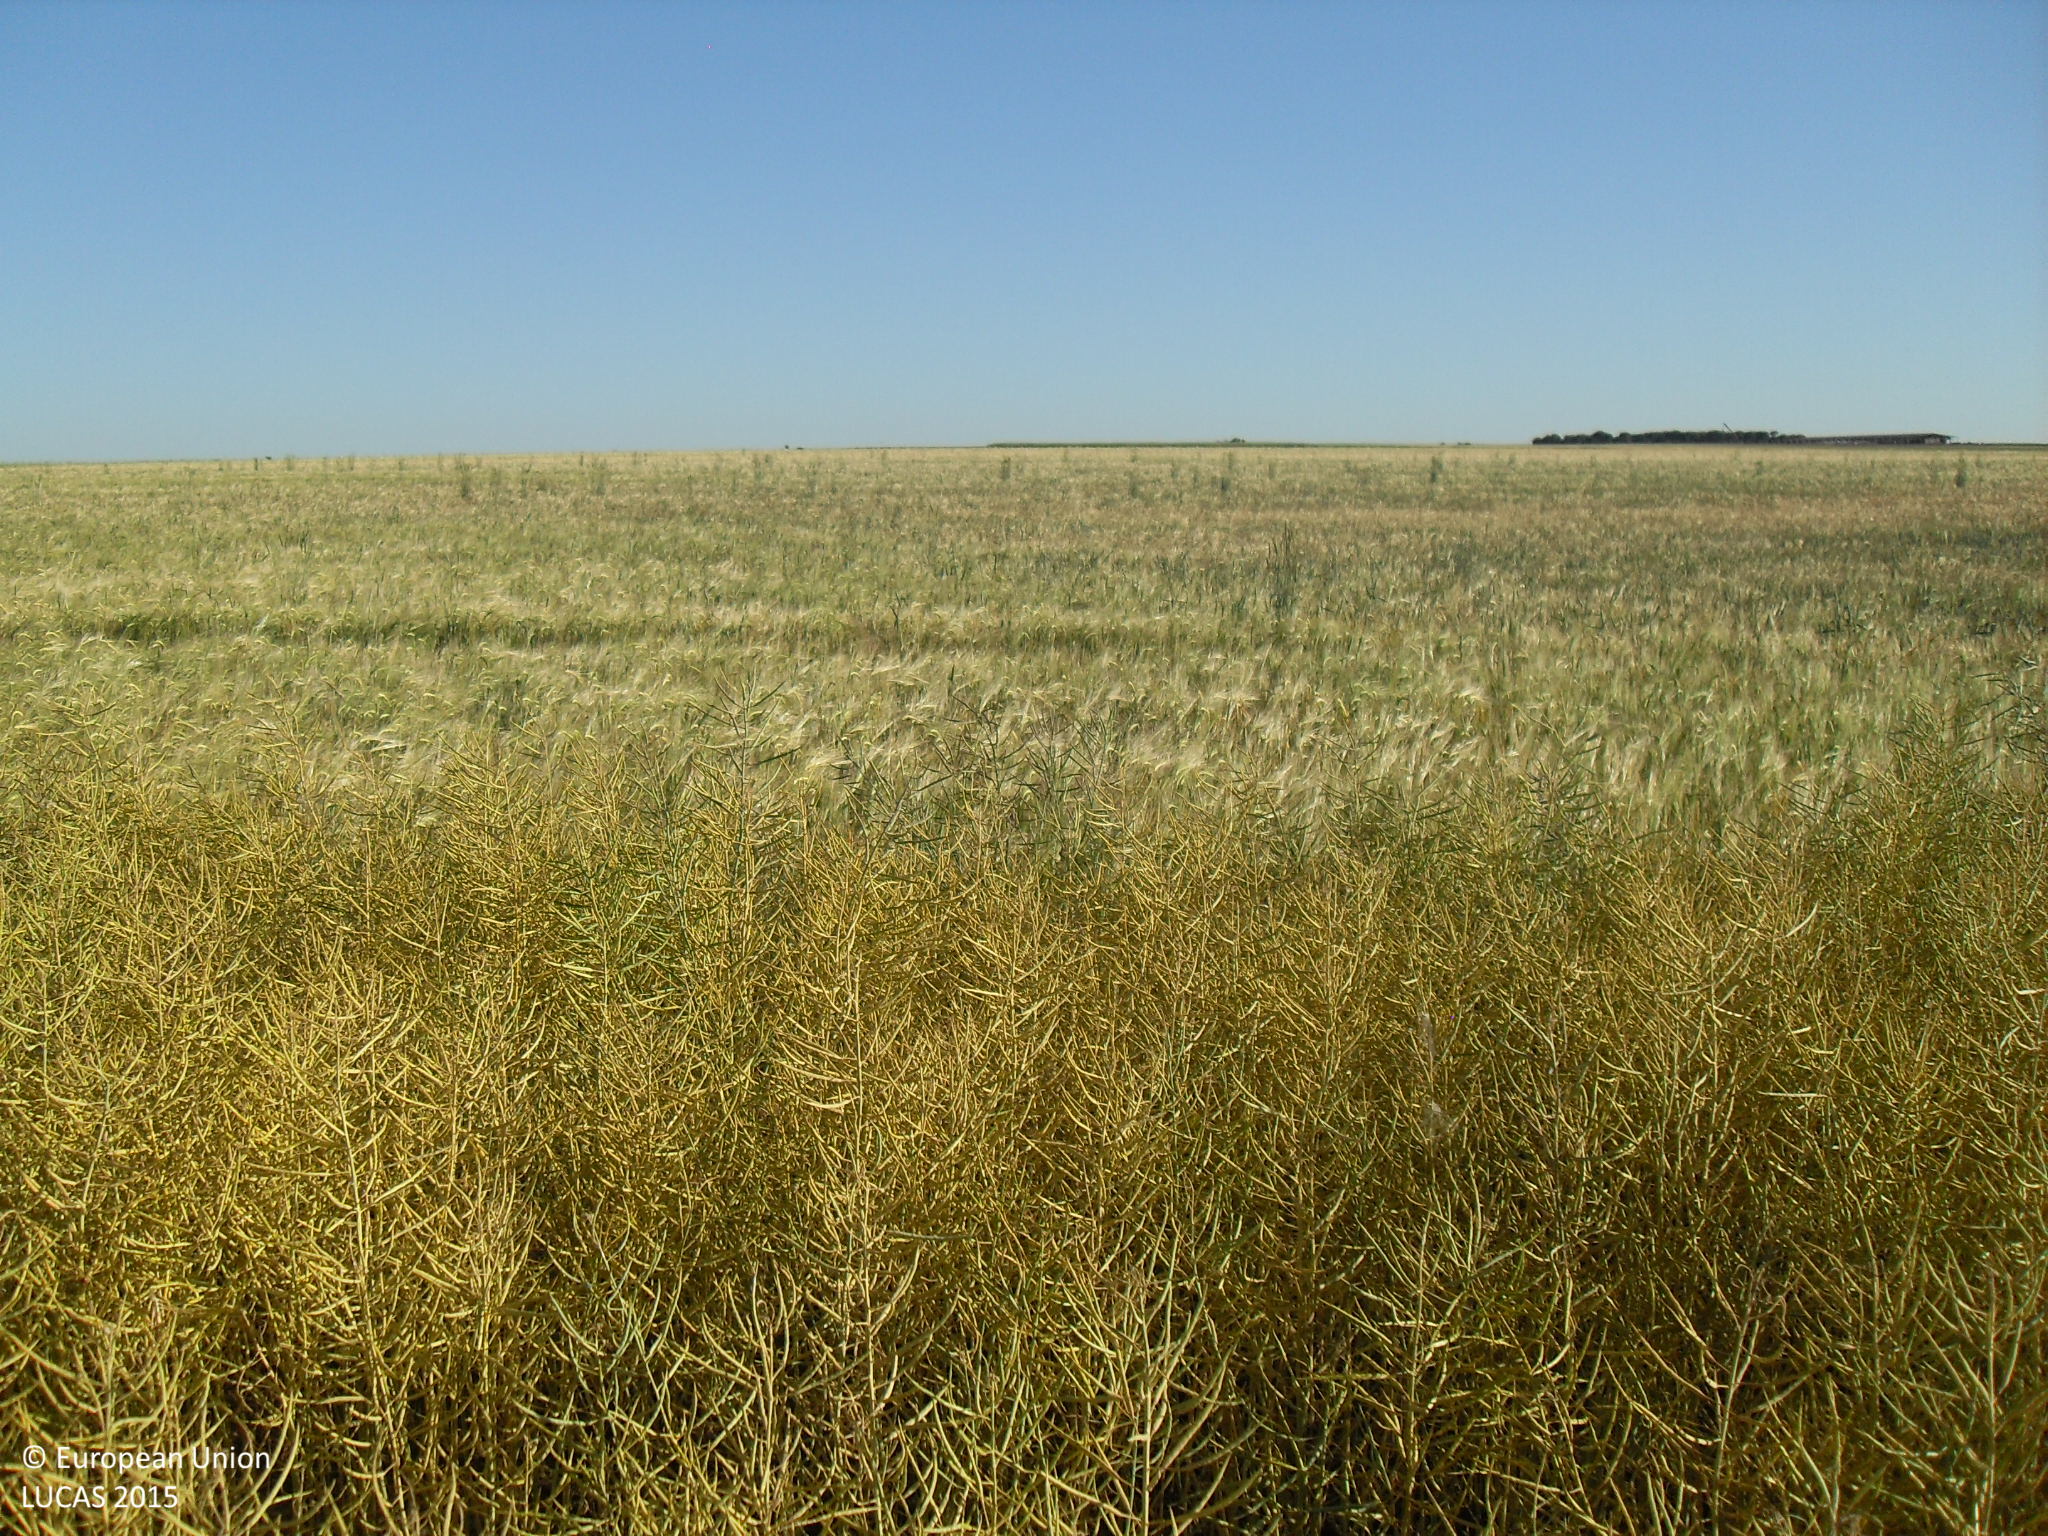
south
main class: Cropland
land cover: Rape and turnip rape
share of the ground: > 75 %
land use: Agriculture (excluding fallow land and kitchen gardens)
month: May
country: ES
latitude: 41.0872
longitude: -5.3702
